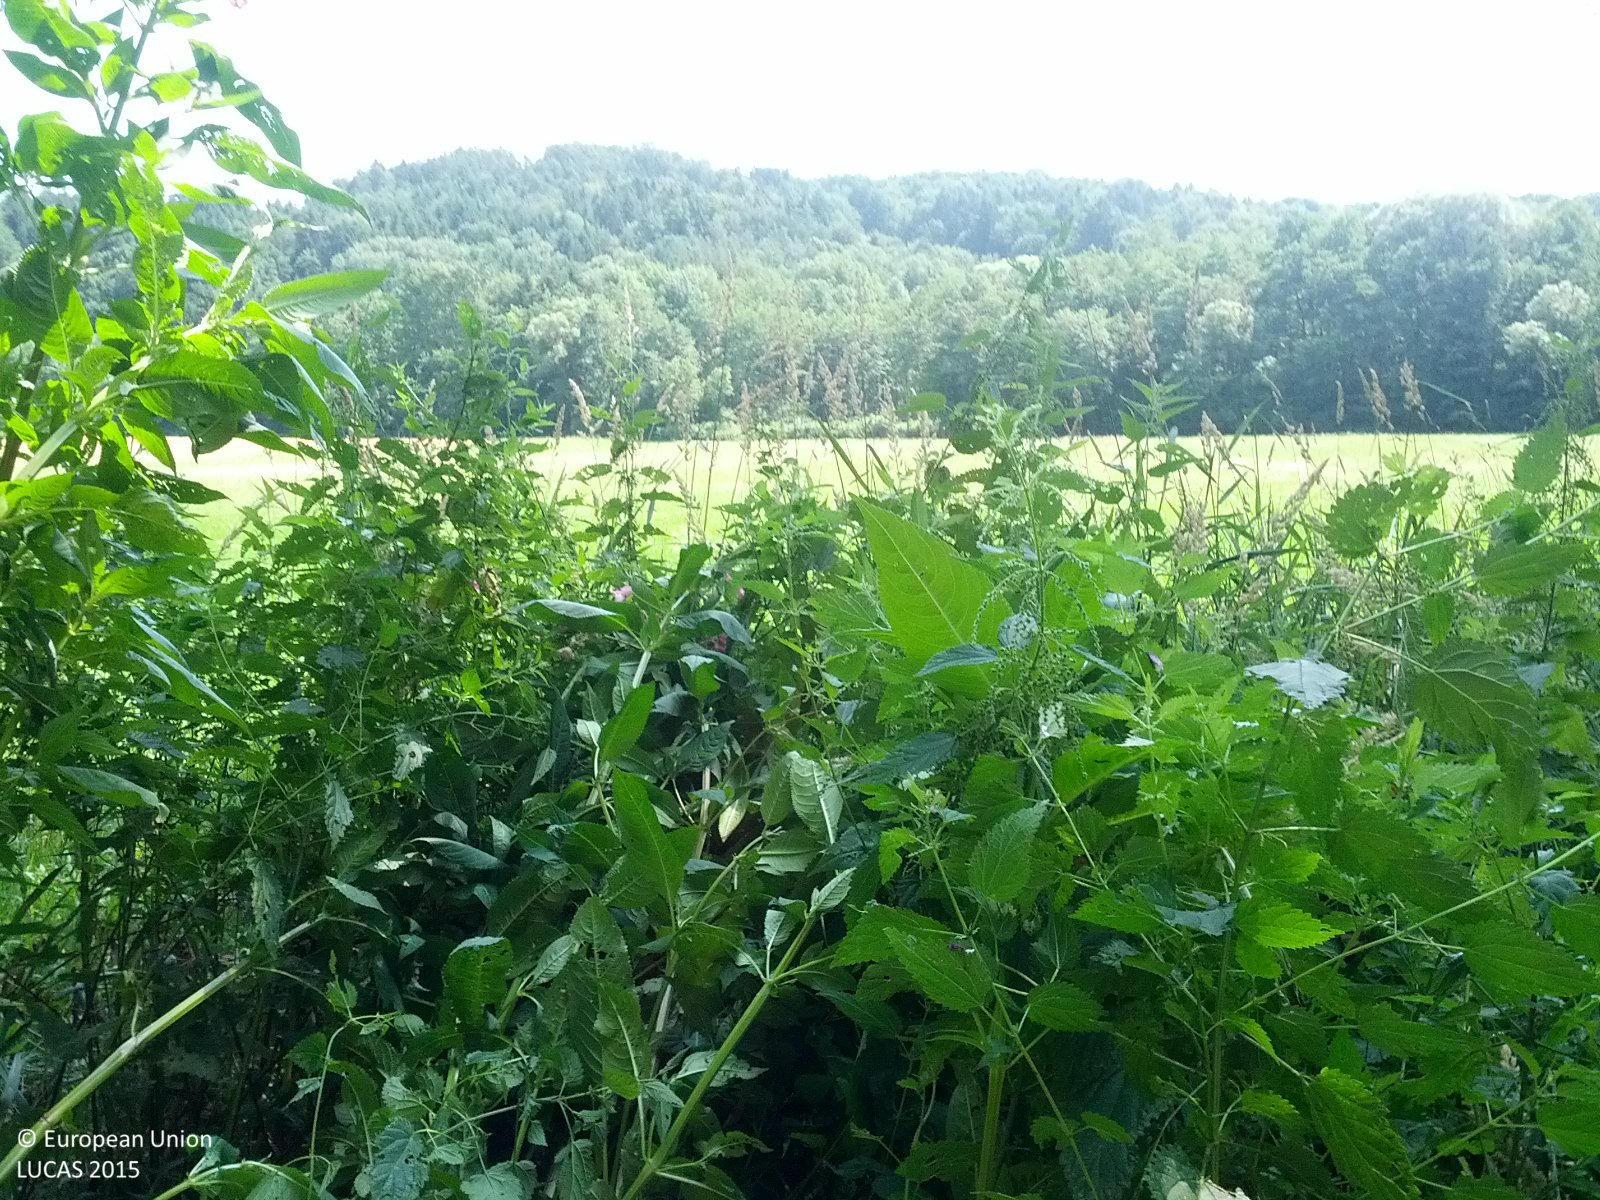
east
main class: Woodland
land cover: Broadleaved woodland
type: floodplain forest
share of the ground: > 75 %
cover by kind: broadleaved forest trees 75 %, herbaceous plants 20 %, shrubs 5 %
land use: Semi-natural and natural areas not in use
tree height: > 5 m
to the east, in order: Broadleaved woodland; Grassland without tree/shrub cover; Tracks; Broadleaved woodland; Shrubland without tree cover; Groves; Grass margins; Tracks; Grass margins; Ditches and canals
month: July
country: AT
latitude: 47.2429
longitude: 16.0921
